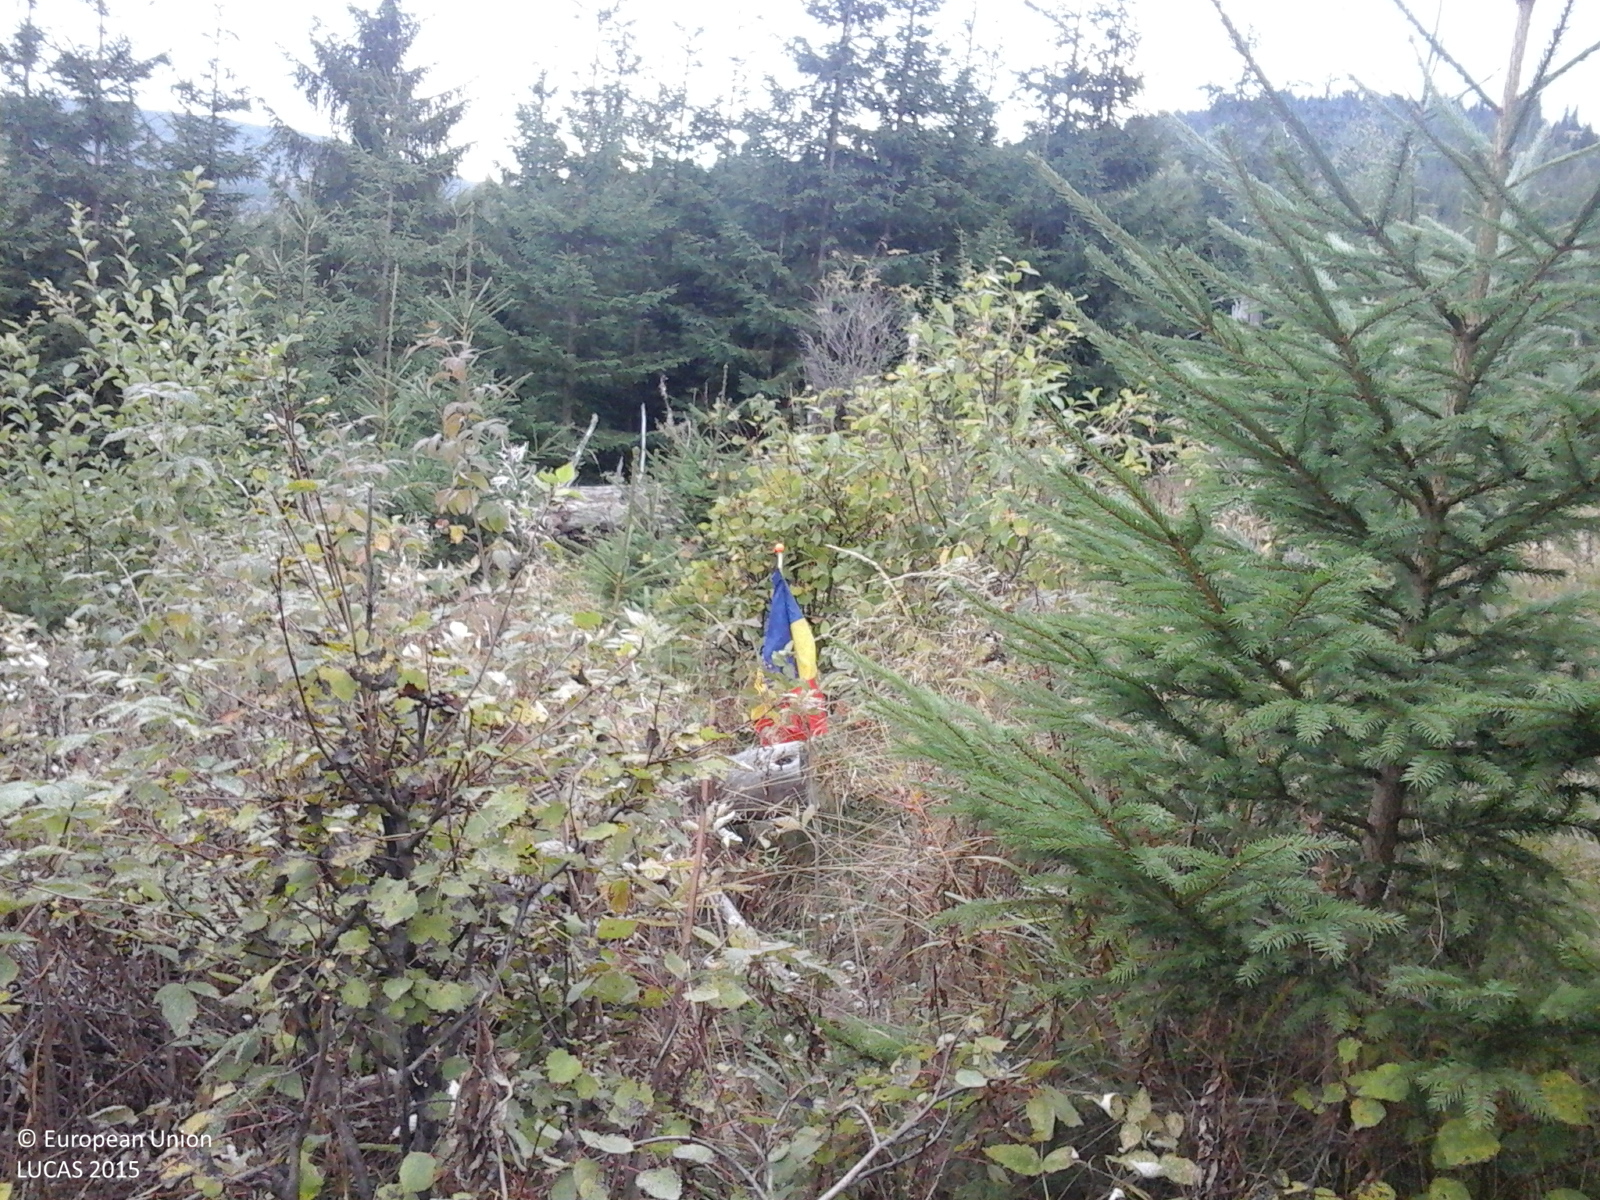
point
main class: Woodland
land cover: Spruce dominated mixed woodland
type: alpine coniferous forest
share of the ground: > 75 %
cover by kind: coniferous forest trees 70 %, broadleaved forest trees 30 %
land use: Forestry
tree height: > 5 m
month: October
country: RO
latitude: 46.5925
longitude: 23.1539
